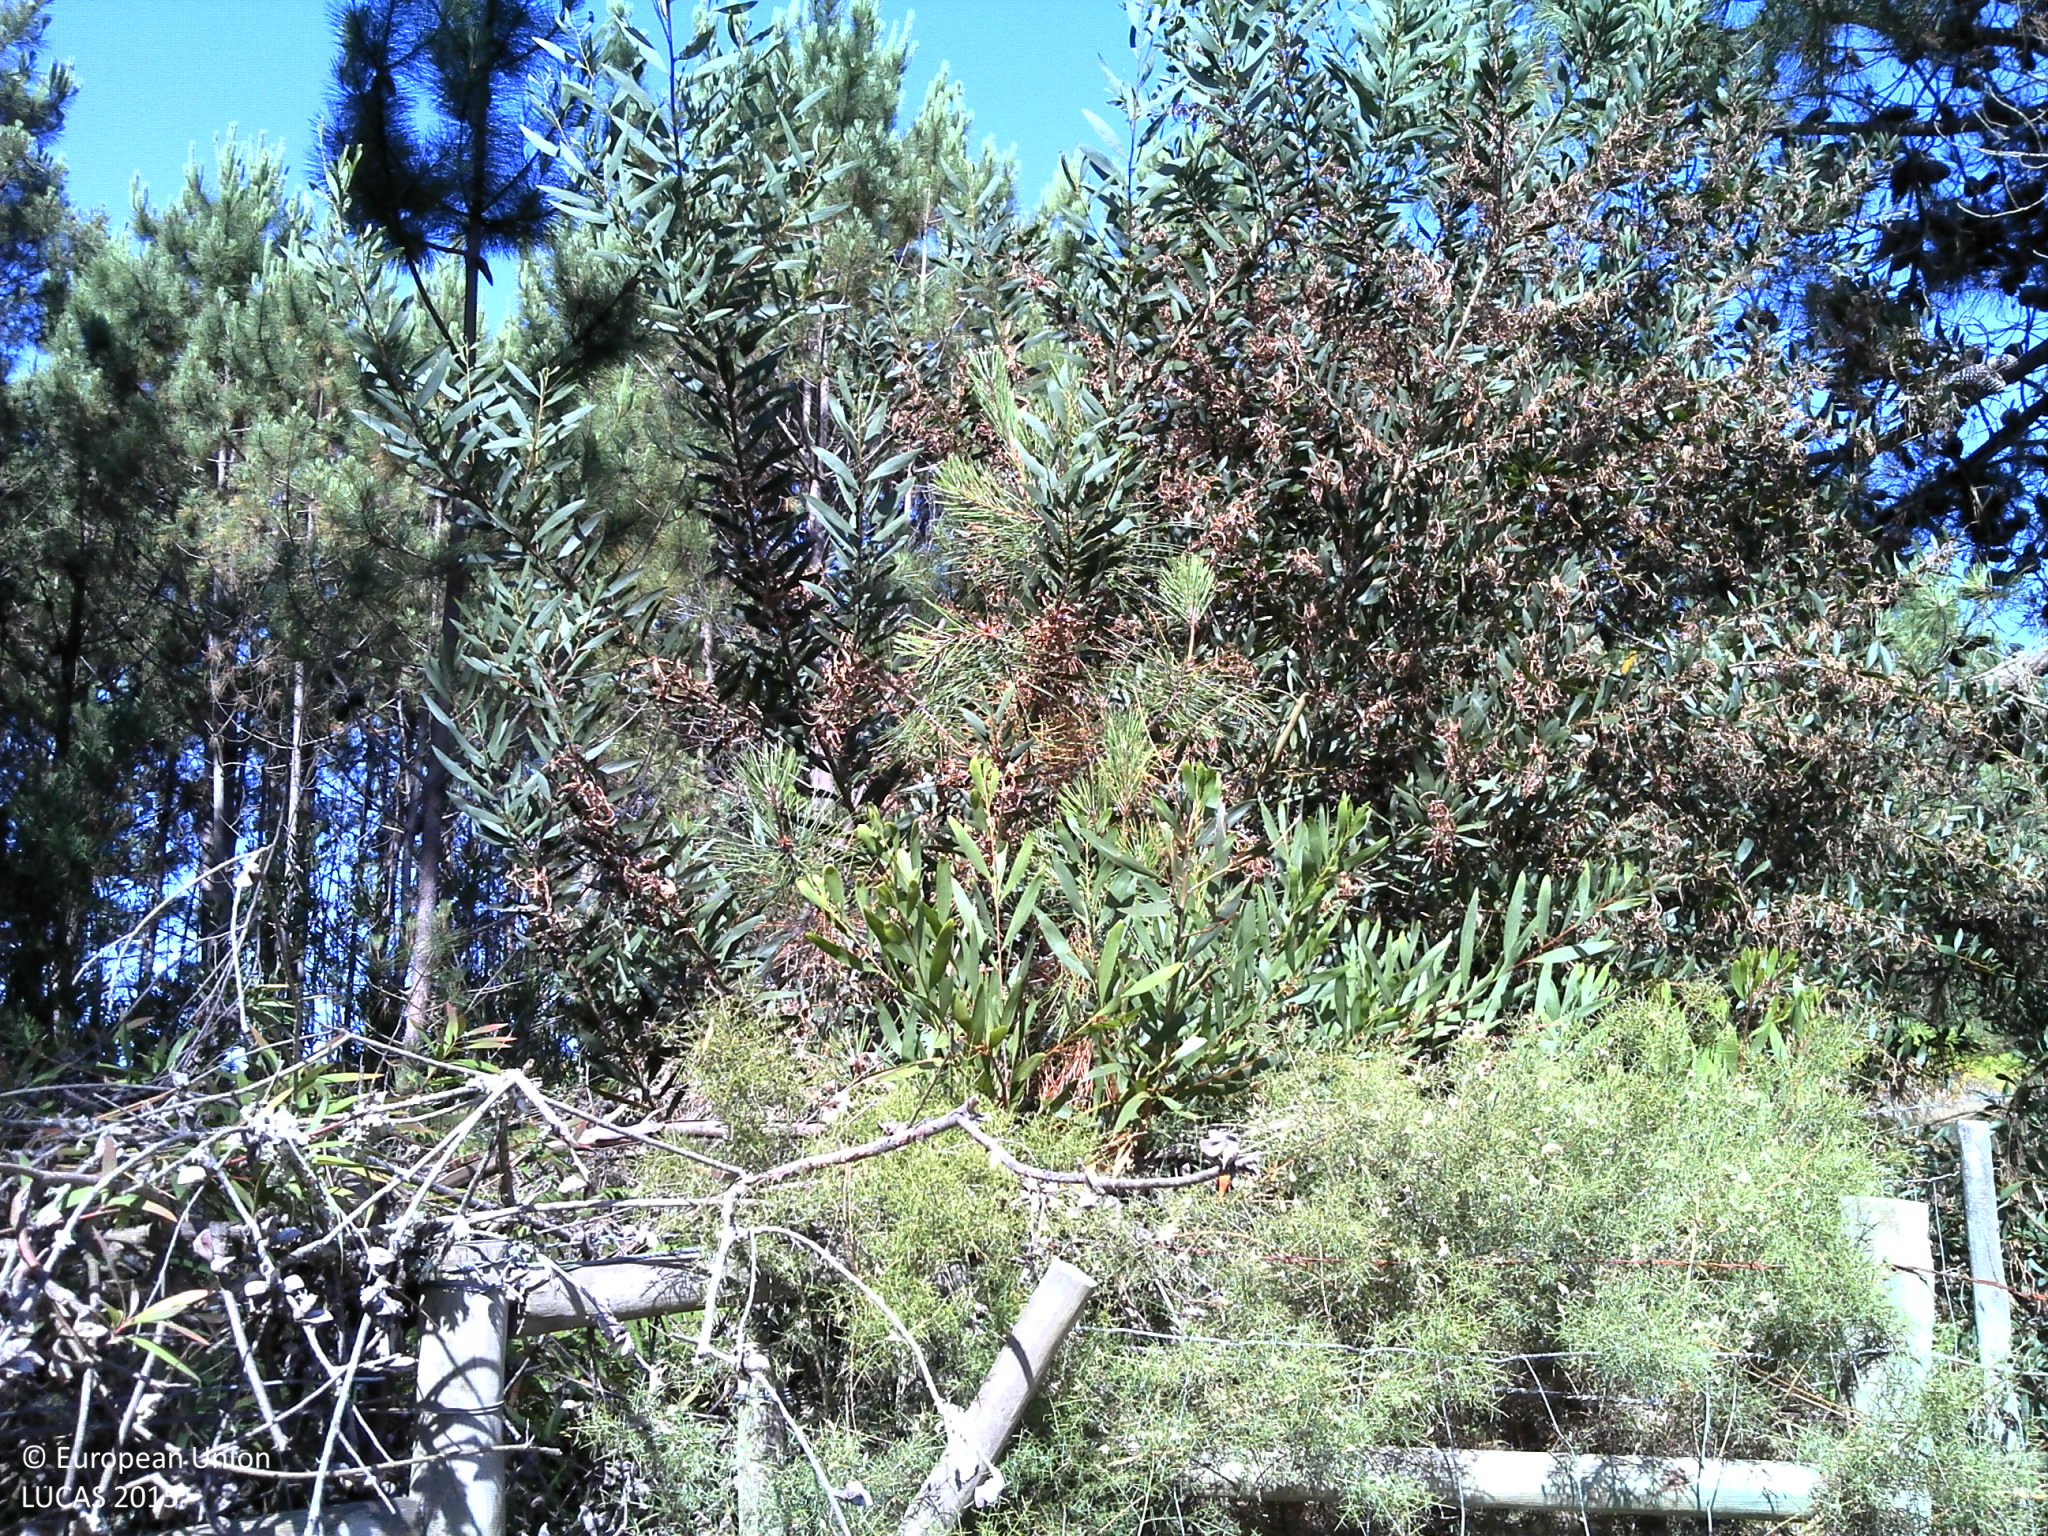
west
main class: Woodland
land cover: Pine dominated coniferous woodland
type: coniferous forest of the mediterranean region
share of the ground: 25 - 50 %
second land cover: Grassland without tree/shrub cover
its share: 25 - 50 %
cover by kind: coniferous forest trees 35 %, herbaceous plants 30 %, unconsolidated bare surface 30 %, shrubs 5 %
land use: Forestry
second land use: Agriculture (excluding fallow land and kitchen gardens)
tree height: > 5 m
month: June
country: PT
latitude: 37.3762
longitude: -8.7947
